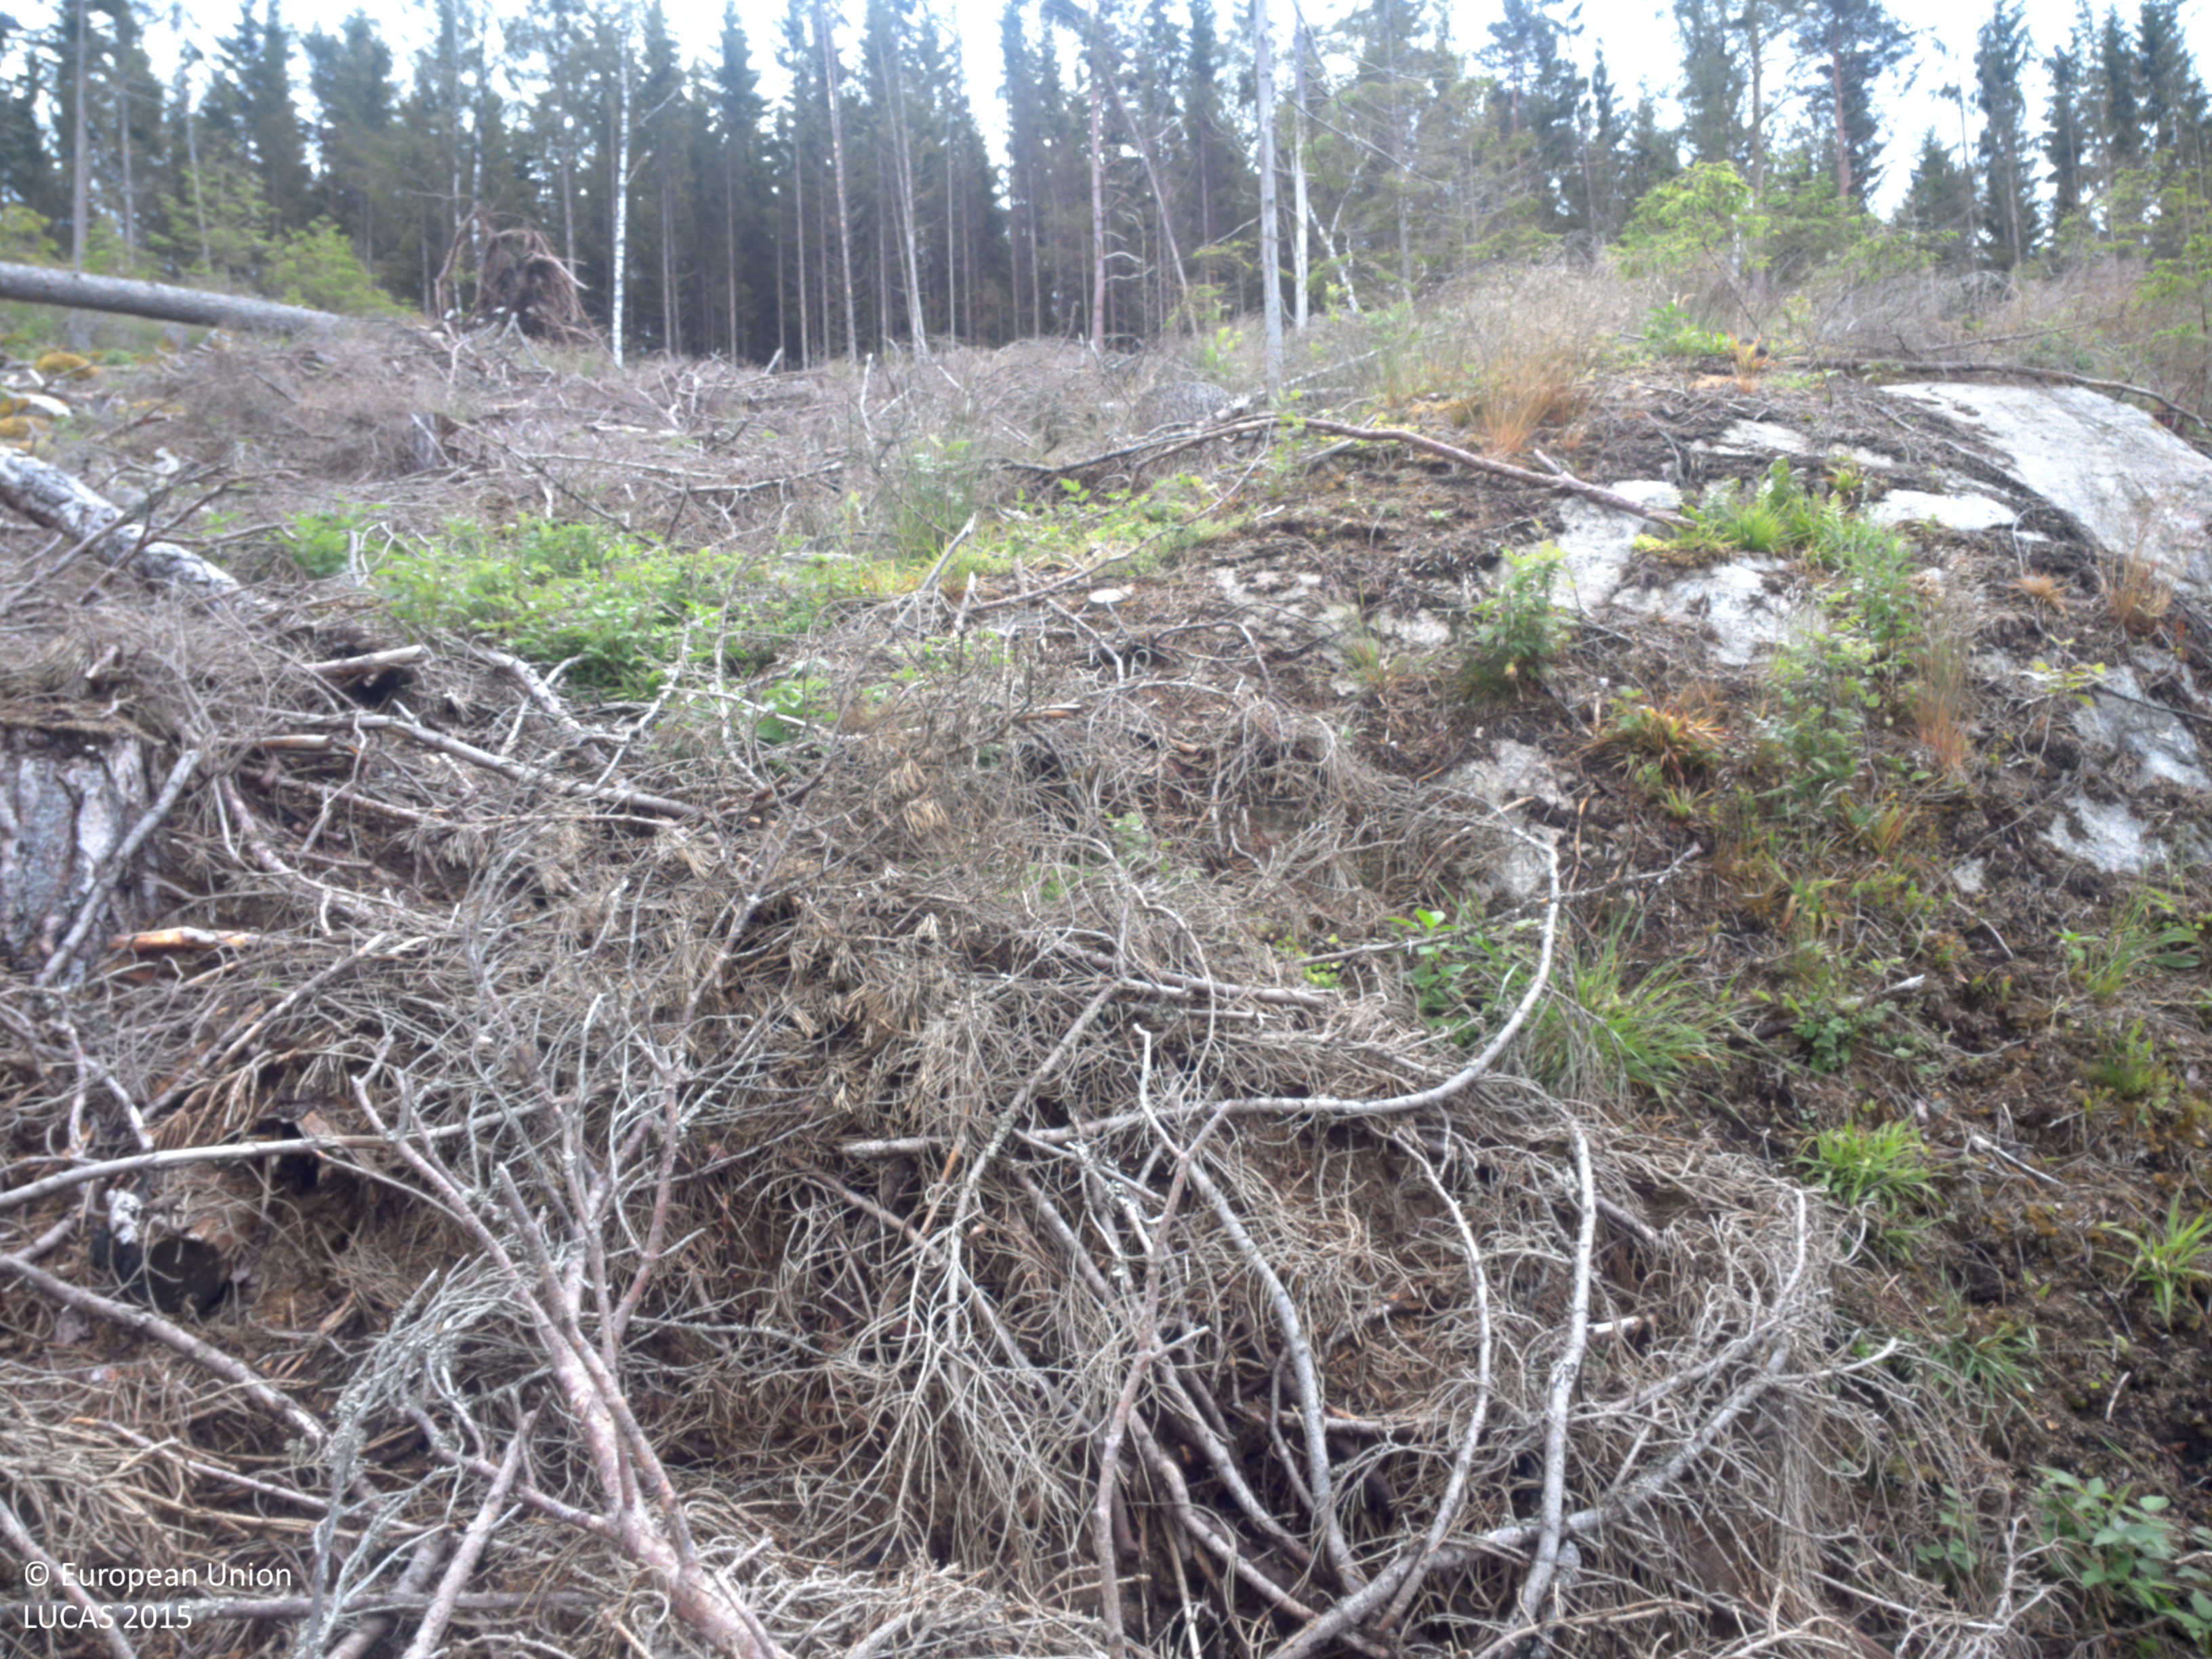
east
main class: Grassland
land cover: Grassland with sparse tree/shrub cover
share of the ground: 25 - 50 %
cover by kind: herbaceous plants 30 %, lichens and mosses 10 %, coniferous forest trees 5 %, shrubs 5 %
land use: Forestry
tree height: > 5 m
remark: Clear cut
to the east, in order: Grassland with sparse tree/shrub cover; Rocks and stones; Grassland with sparse tree/shrub cover; Spruce dominated coniferous woodland; Tracks; Spruce dominated coniferous woodland; Spruce dominated mixed woodland; Tracks; Spruce dominated mixed woodland; Spruce dominated coniferous woodland; Ditches and canals; Spruce dominated coniferous woodland; Rivers and streams; Spruce dominated coniferous woodland; Tracks; Spruce dominated coniferous woodland
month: June
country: SE
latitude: 59.1422
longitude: 11.8658
